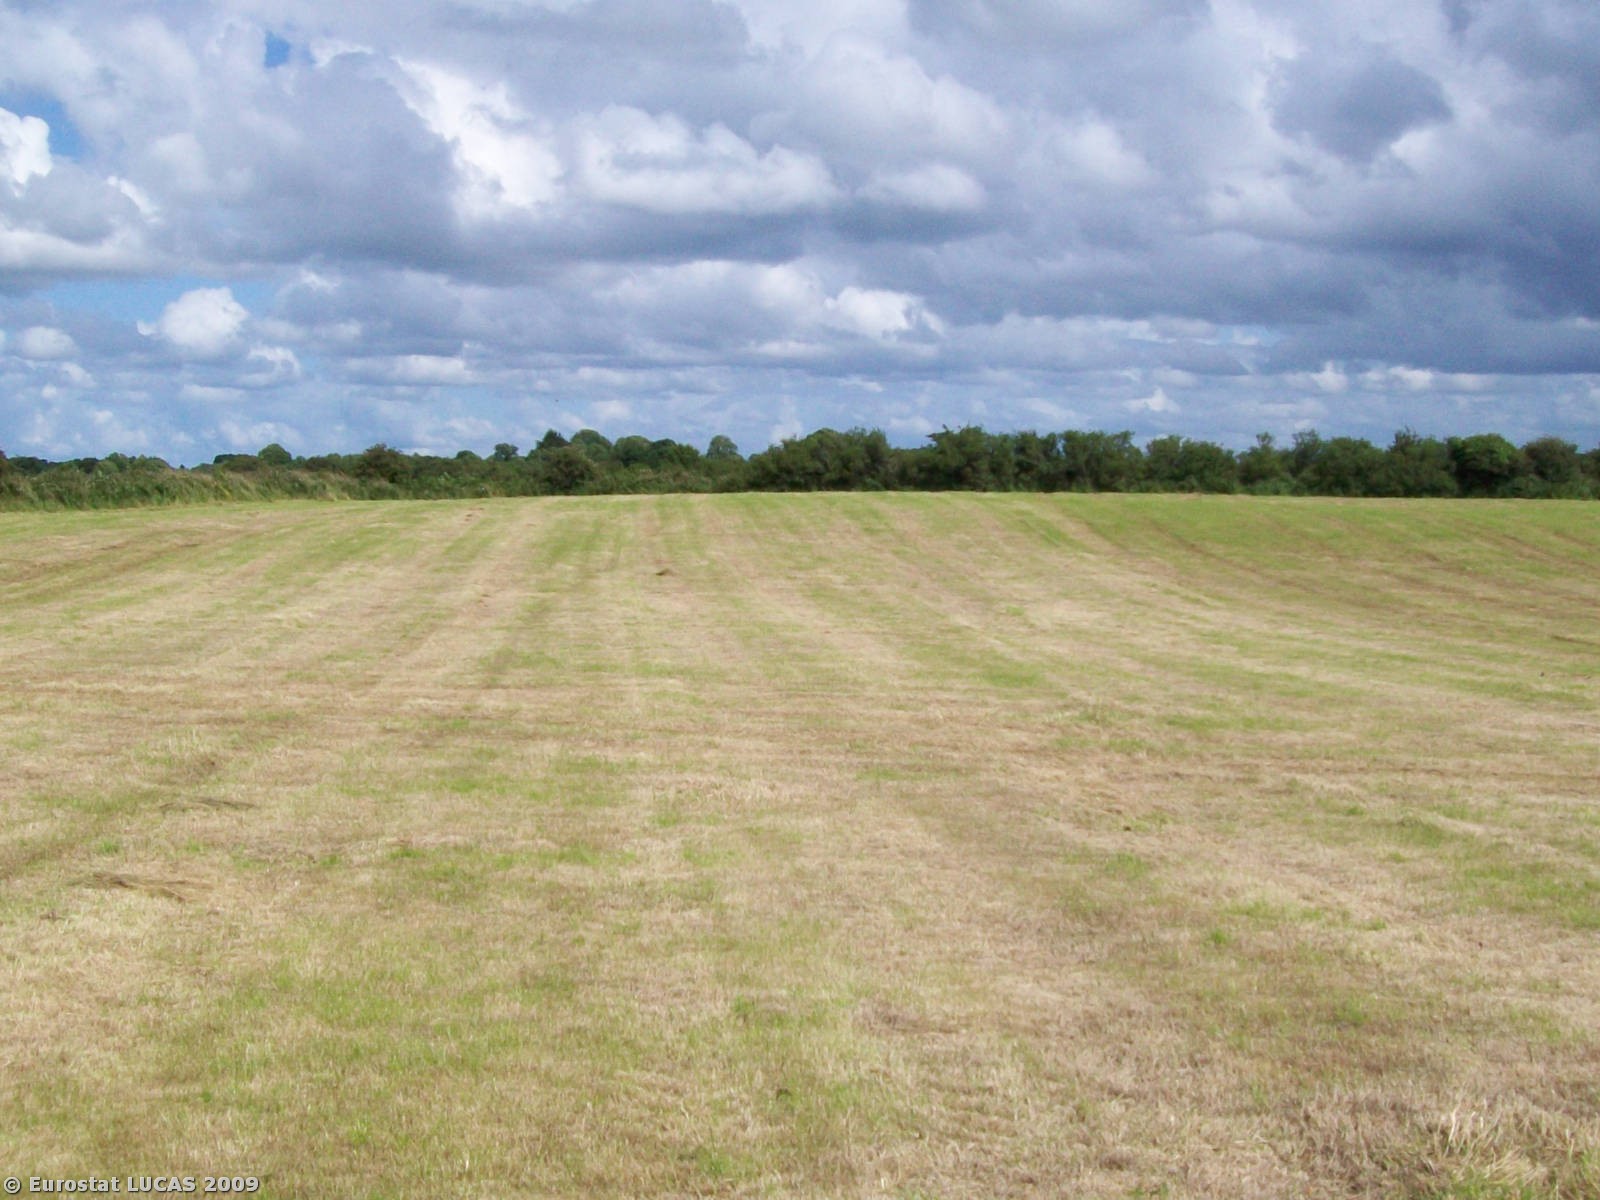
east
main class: Grassland
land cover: Grassland without tree/shrub cover
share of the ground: > 75 %
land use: Agriculture (excluding fallow land and kitchen gardens)
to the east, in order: Grassland without tree/shrub cover; Broadleaved woodland; Grassland without tree/shrub cover; Broadleaved woodland; Dry stone walls; Grassland without tree/shrub cover; Dry stone walls; Paved roads, cycling and walking lanes
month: July
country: IE
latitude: 53.1938
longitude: -8.7480
